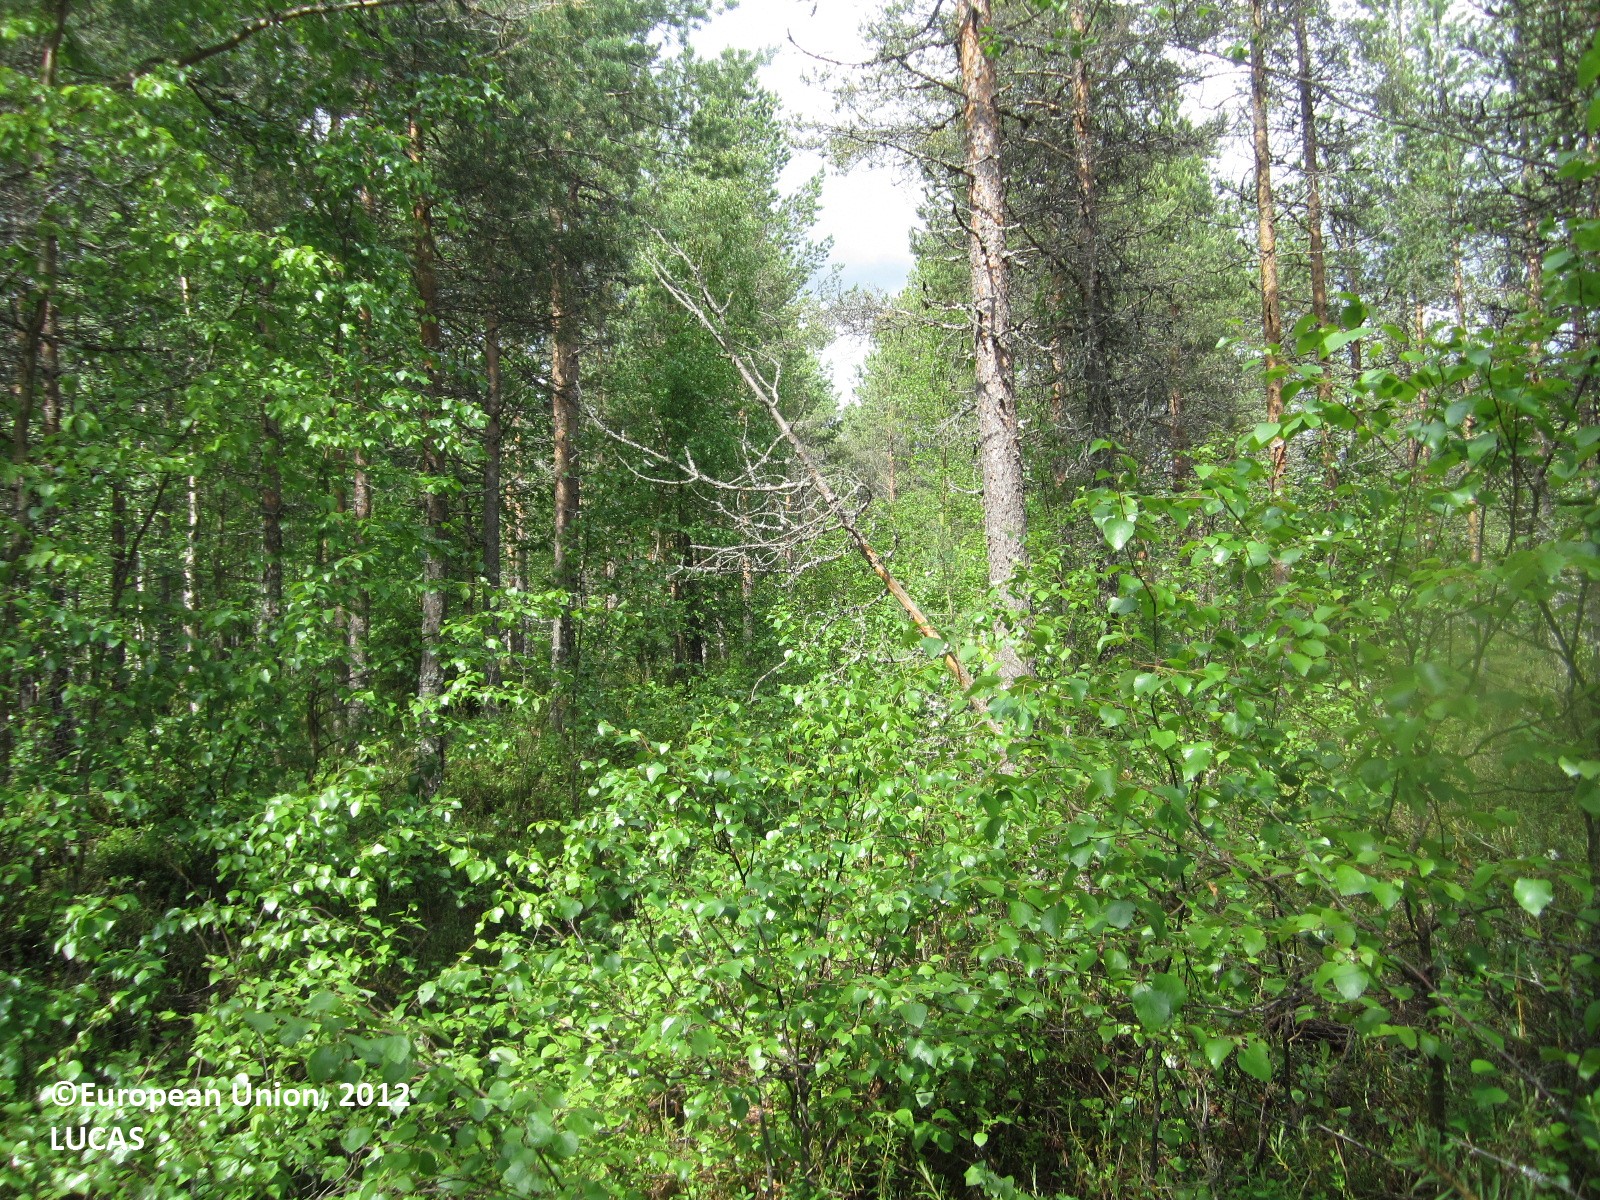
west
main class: Woodland
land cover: Pine dominated mixed woodland
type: boreal forest
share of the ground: 50 - 75 %
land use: Forestry
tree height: > 5 m
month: June
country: FI
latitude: 64.3885
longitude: 29.7785
